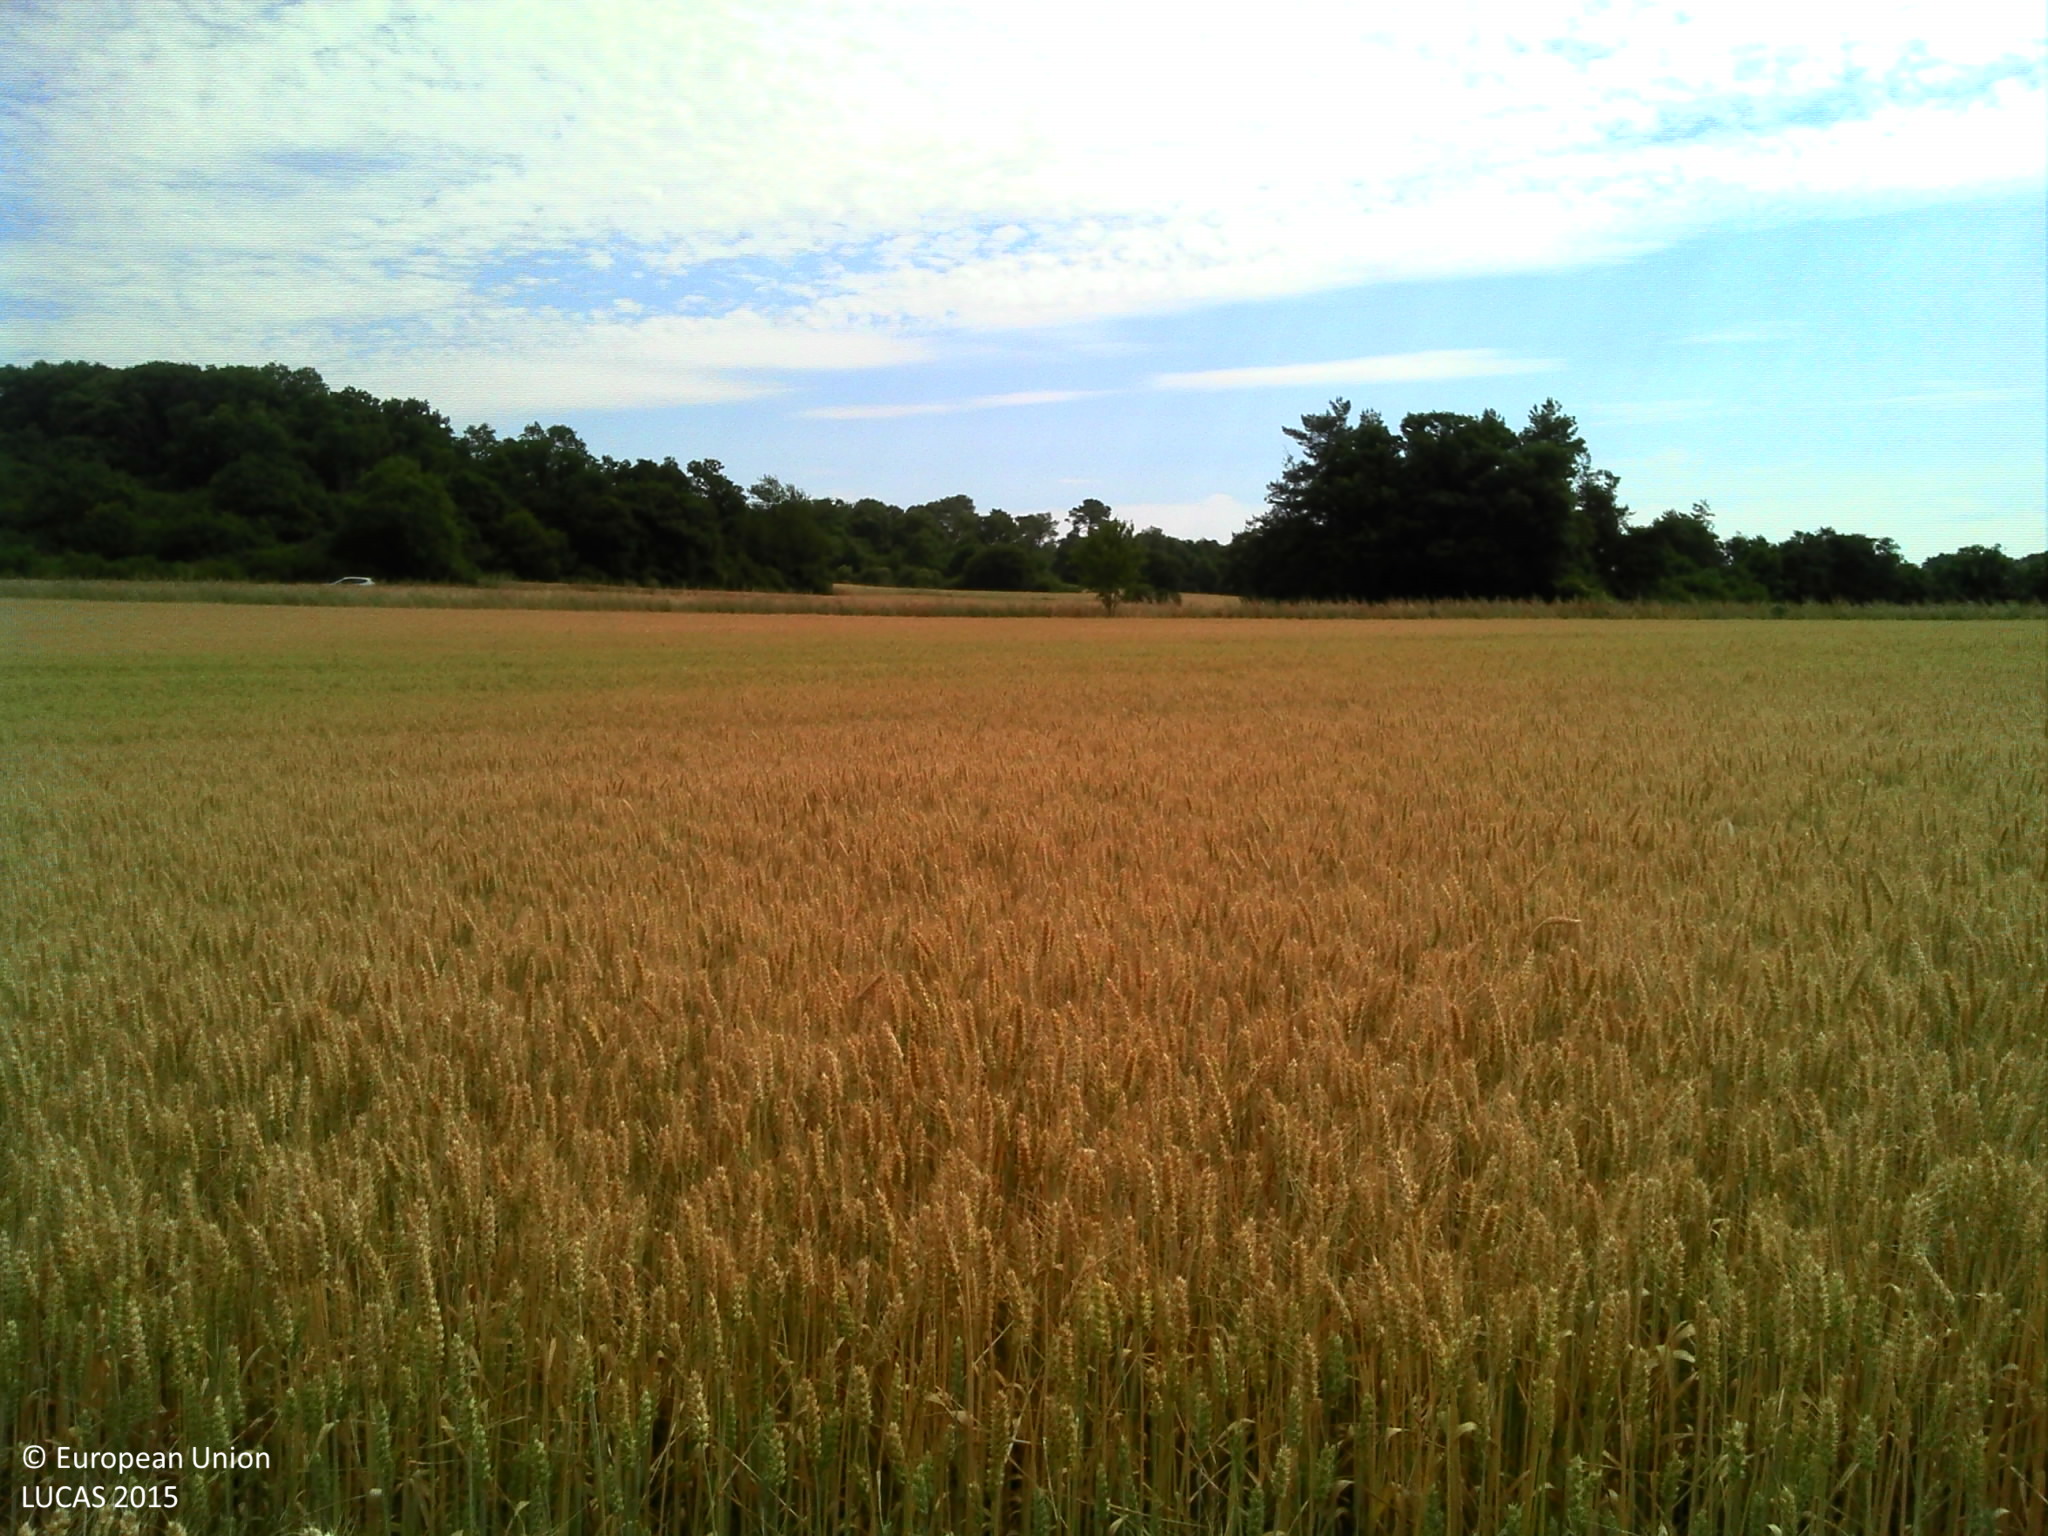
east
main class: Woodland
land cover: Broadleaved woodland
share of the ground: > 75 %
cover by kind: broadleaved forest trees 50 %, herbaceous plants 50 %
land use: Forestry
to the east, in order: Broadleaved woodland; Grassland without tree/shrub cover; Fences; Common wheat; Grass margins; Ditches and canals; Grass margins; Tracks; Grass margins; Ditches and canals; Grass margins; Broadleaved woodland; Common wheat
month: June
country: FR
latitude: 47.9554
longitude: -2.0917
